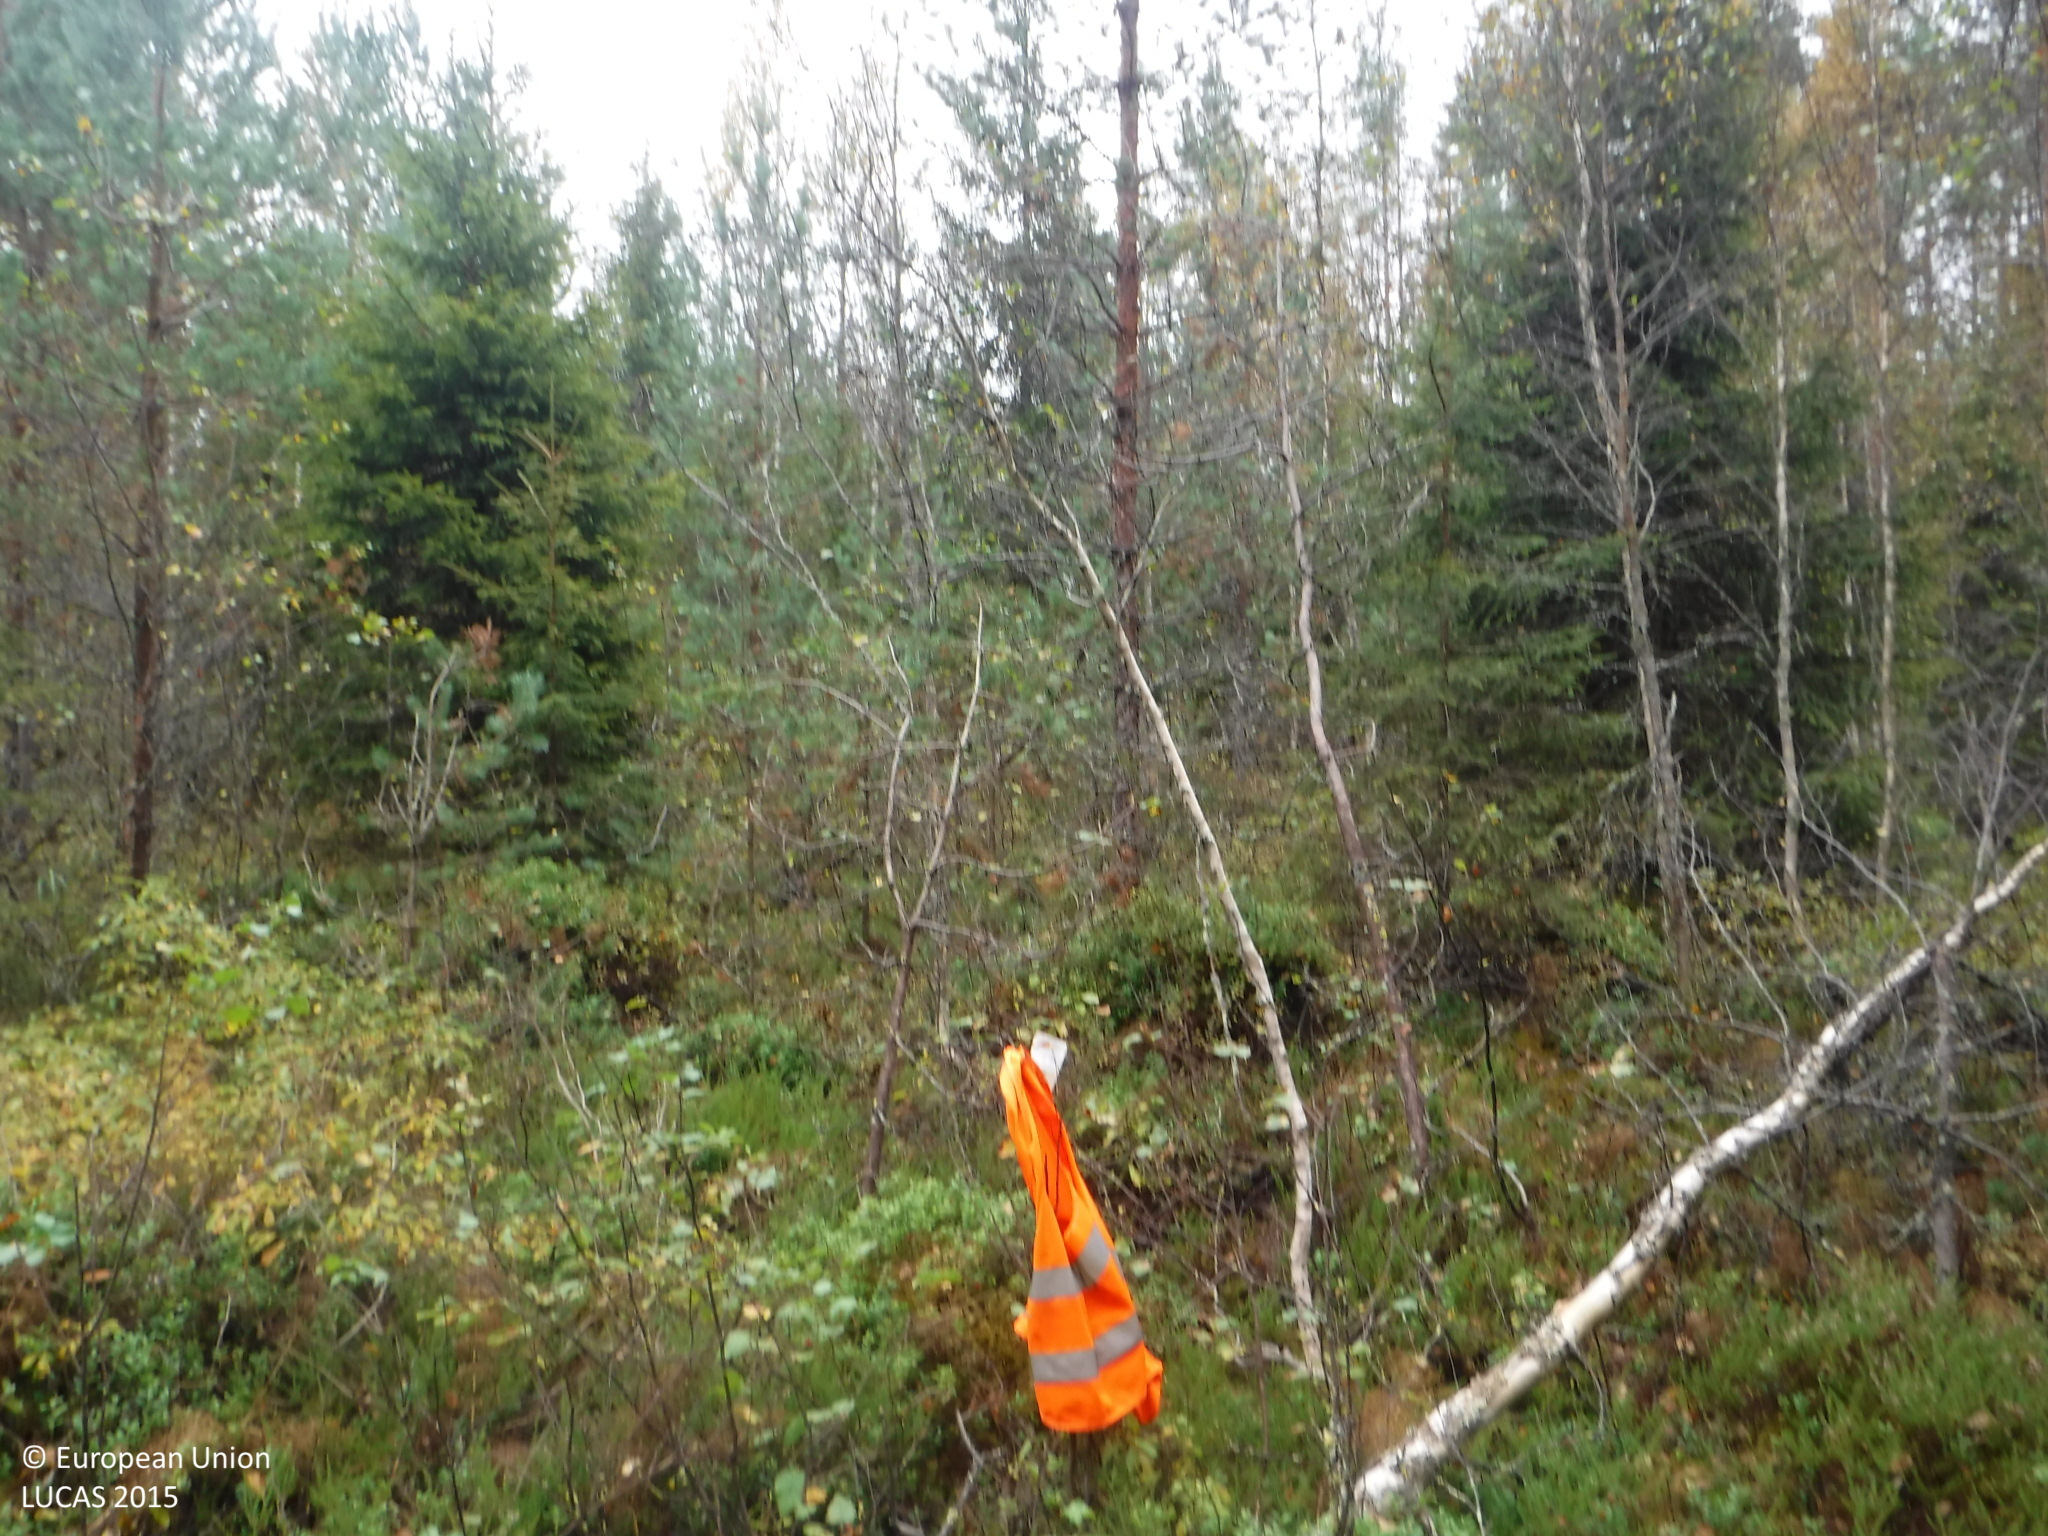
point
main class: Woodland
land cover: Other mixed woodland
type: boreal forest
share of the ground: 50 - 75 %
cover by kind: shrubs 40 %, broadleaved forest trees 30 %, coniferous forest trees 20 %, lichens and mosses 10 %
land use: Forestry
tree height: > 5 m
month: September
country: FI
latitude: 62.0280
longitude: 23.1996
